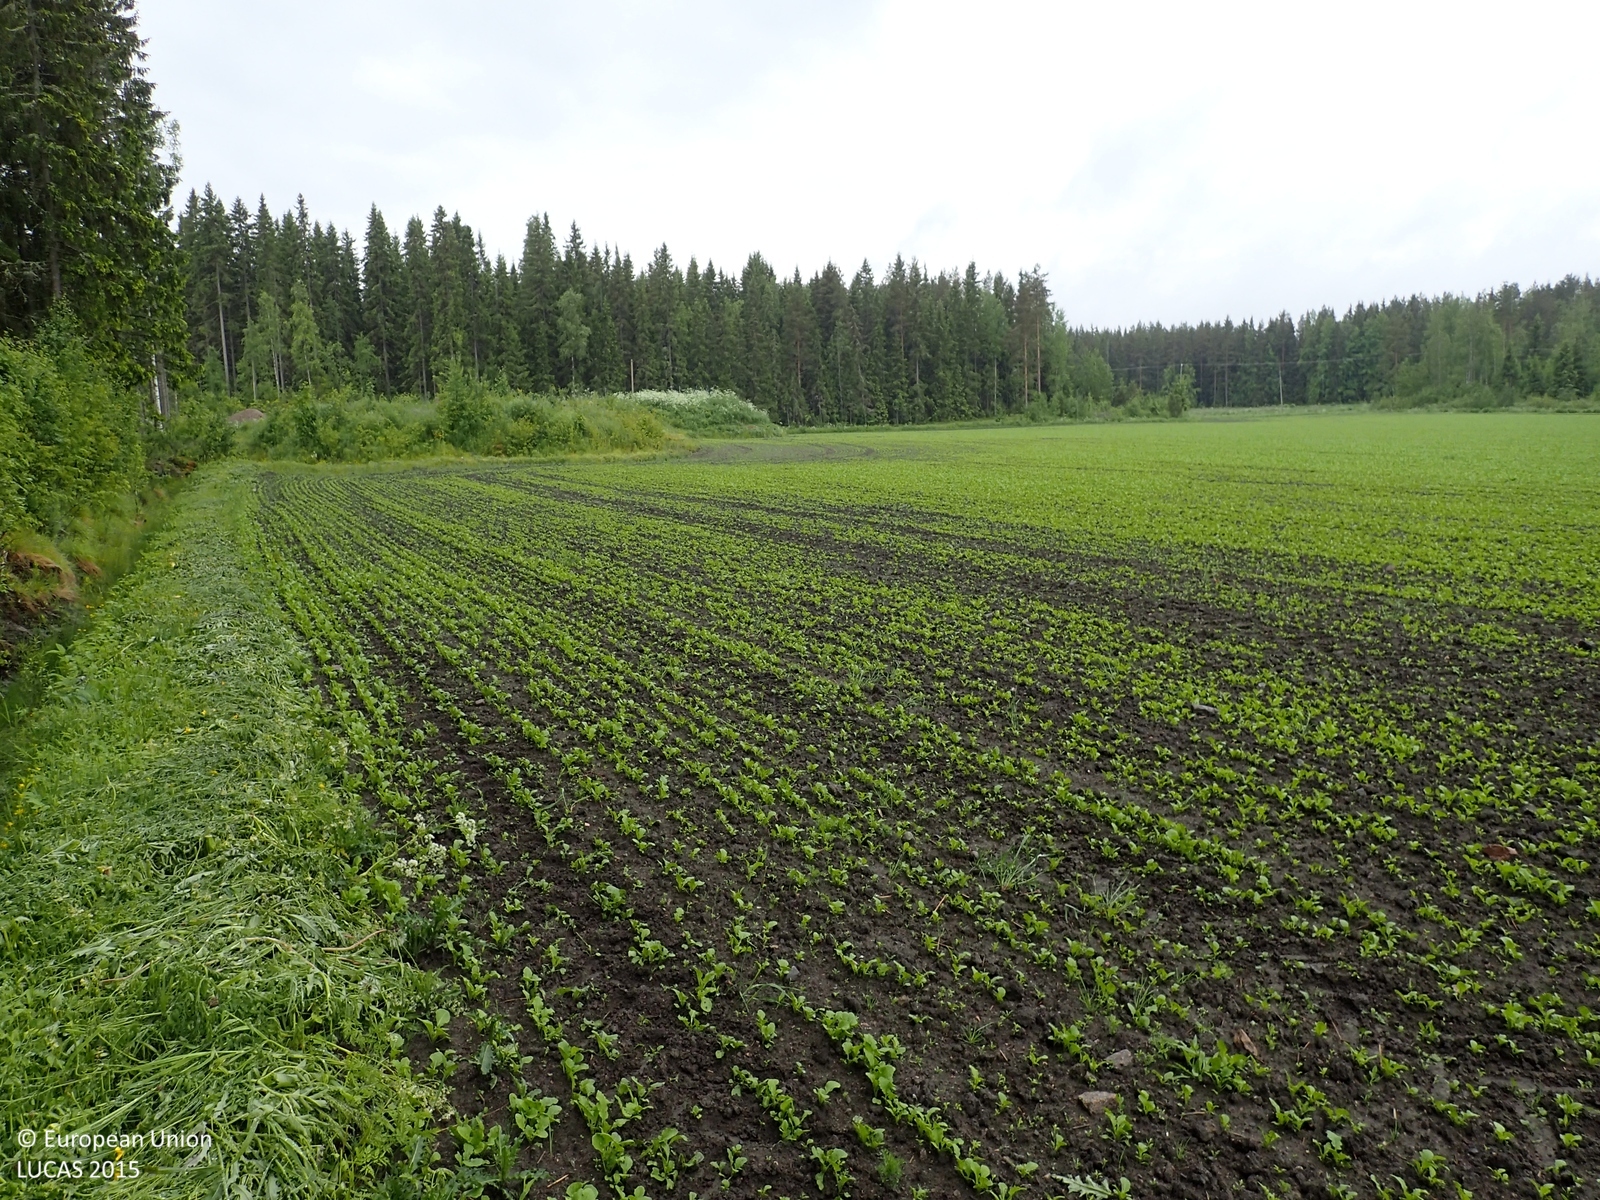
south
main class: Cropland
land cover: Rape and turnip rape
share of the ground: 50 - 75 %
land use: Agriculture (excluding fallow land and kitchen gardens)
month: June
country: FI
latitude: 62.2199
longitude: 21.5664
